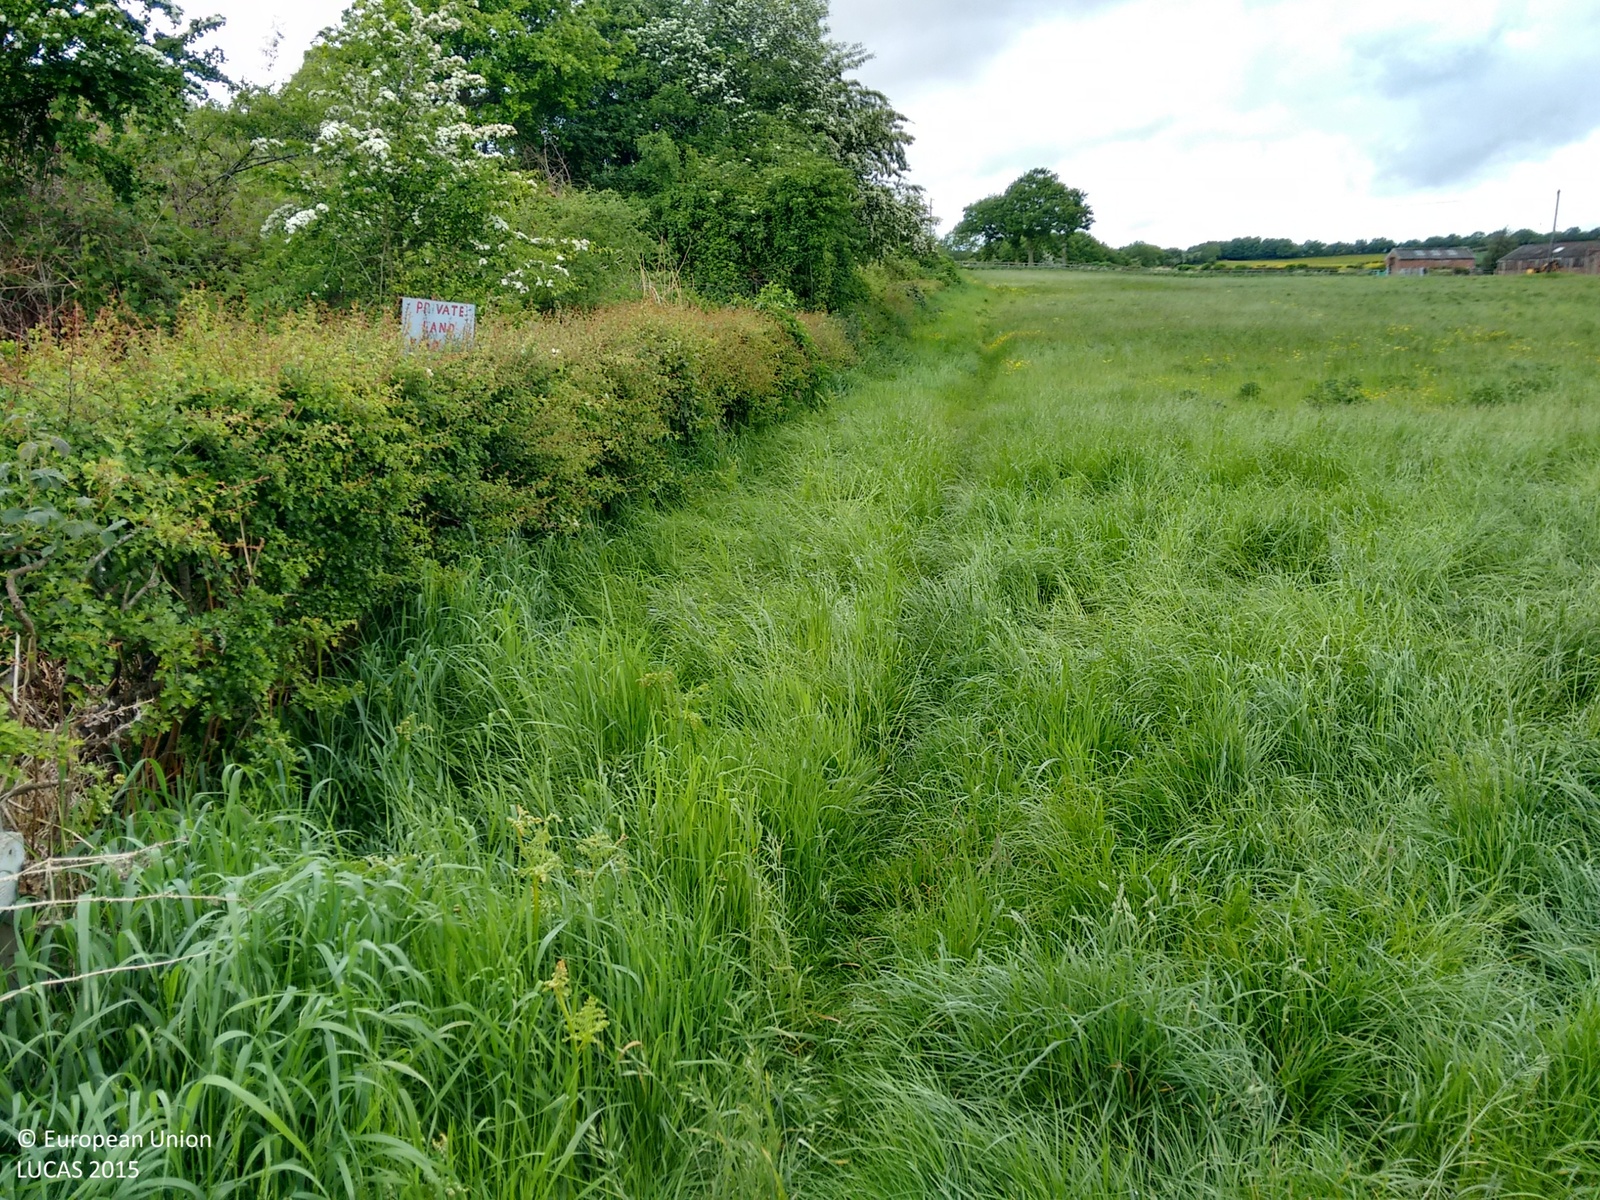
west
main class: Grassland
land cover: Grassland without tree/shrub cover
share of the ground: > 75 %
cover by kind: herbaceous plants 100 %
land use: Agriculture (excluding fallow land and kitchen gardens)
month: June
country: GB
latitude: 52.5395
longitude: -1.5370
